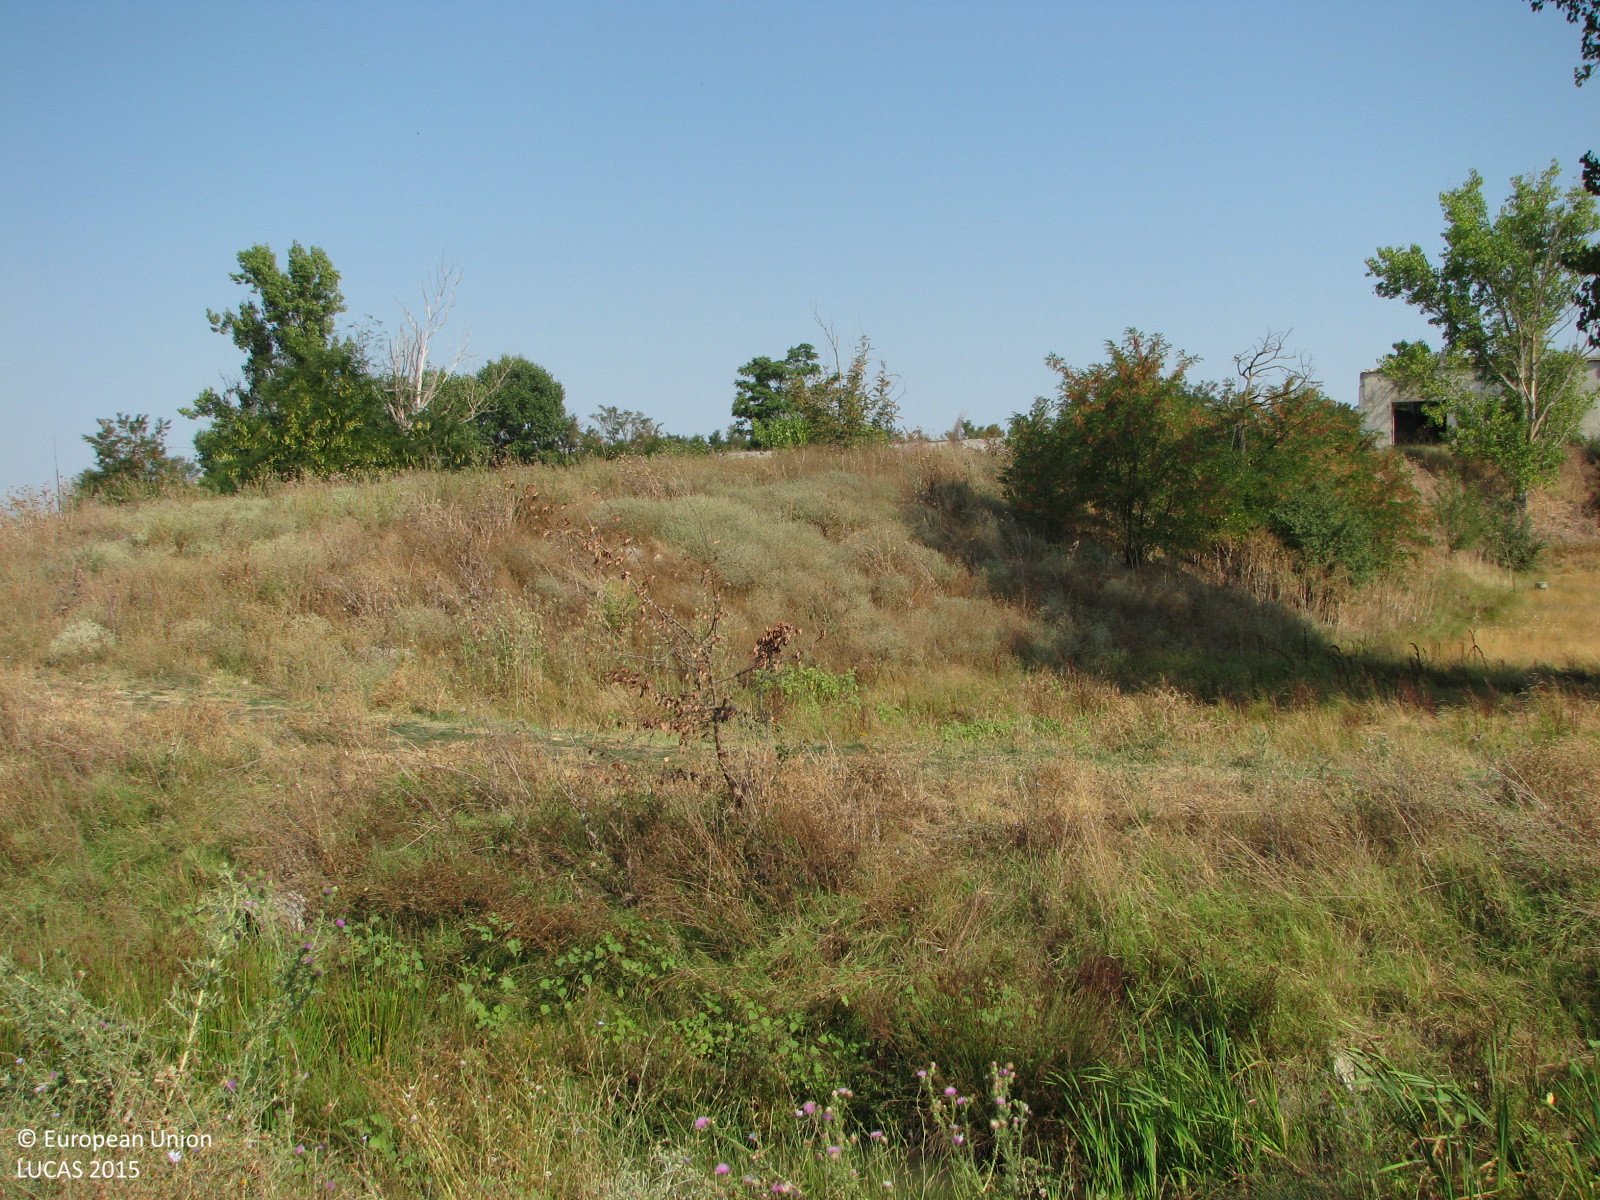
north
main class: Grassland
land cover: Grassland without tree/shrub cover
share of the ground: > 75 %
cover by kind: herbaceous plants 95 %, shrubs 5 %
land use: Agriculture (excluding fallow land and kitchen gardens)
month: August
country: BG
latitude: 42.1624
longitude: 26.5624
